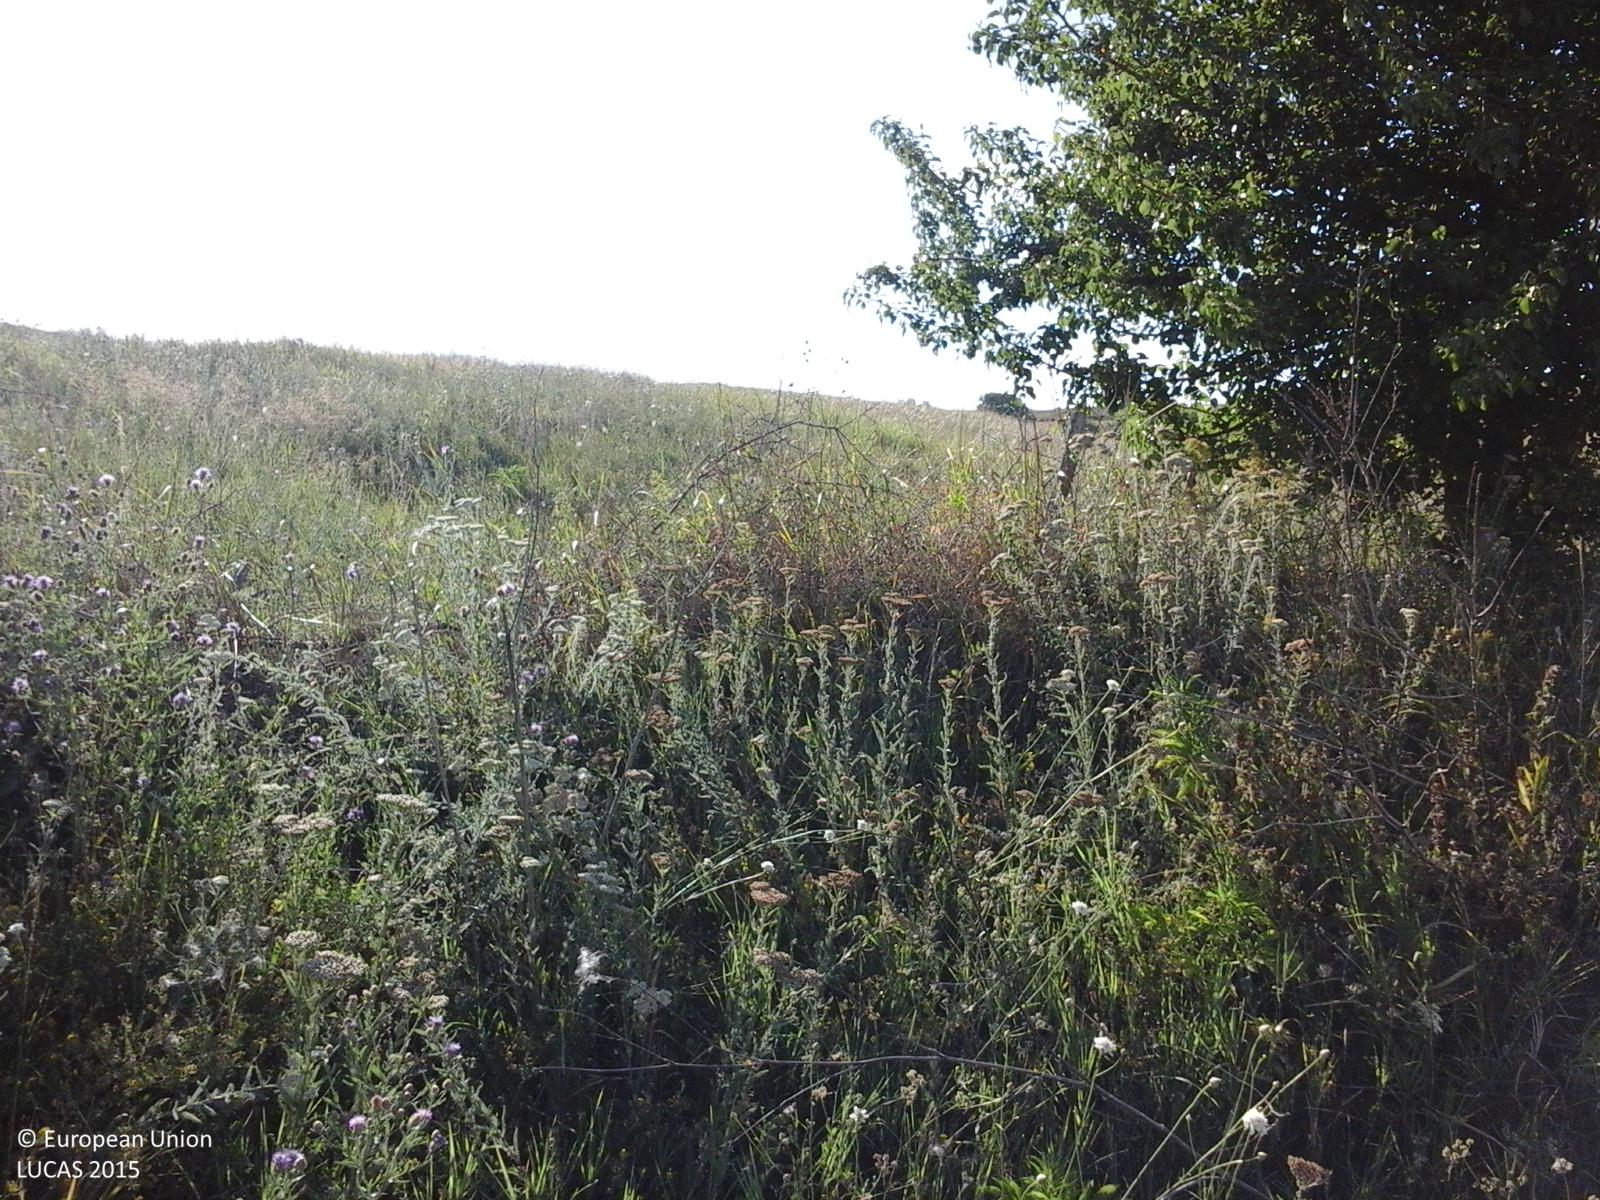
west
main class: Cropland
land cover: Maize
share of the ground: > 75 %
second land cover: Spontaneously vegetated surfaces
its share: > 75 %
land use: Agriculture (excluding fallow land and kitchen gardens)
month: July
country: RO
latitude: 46.0390
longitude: 27.6992
